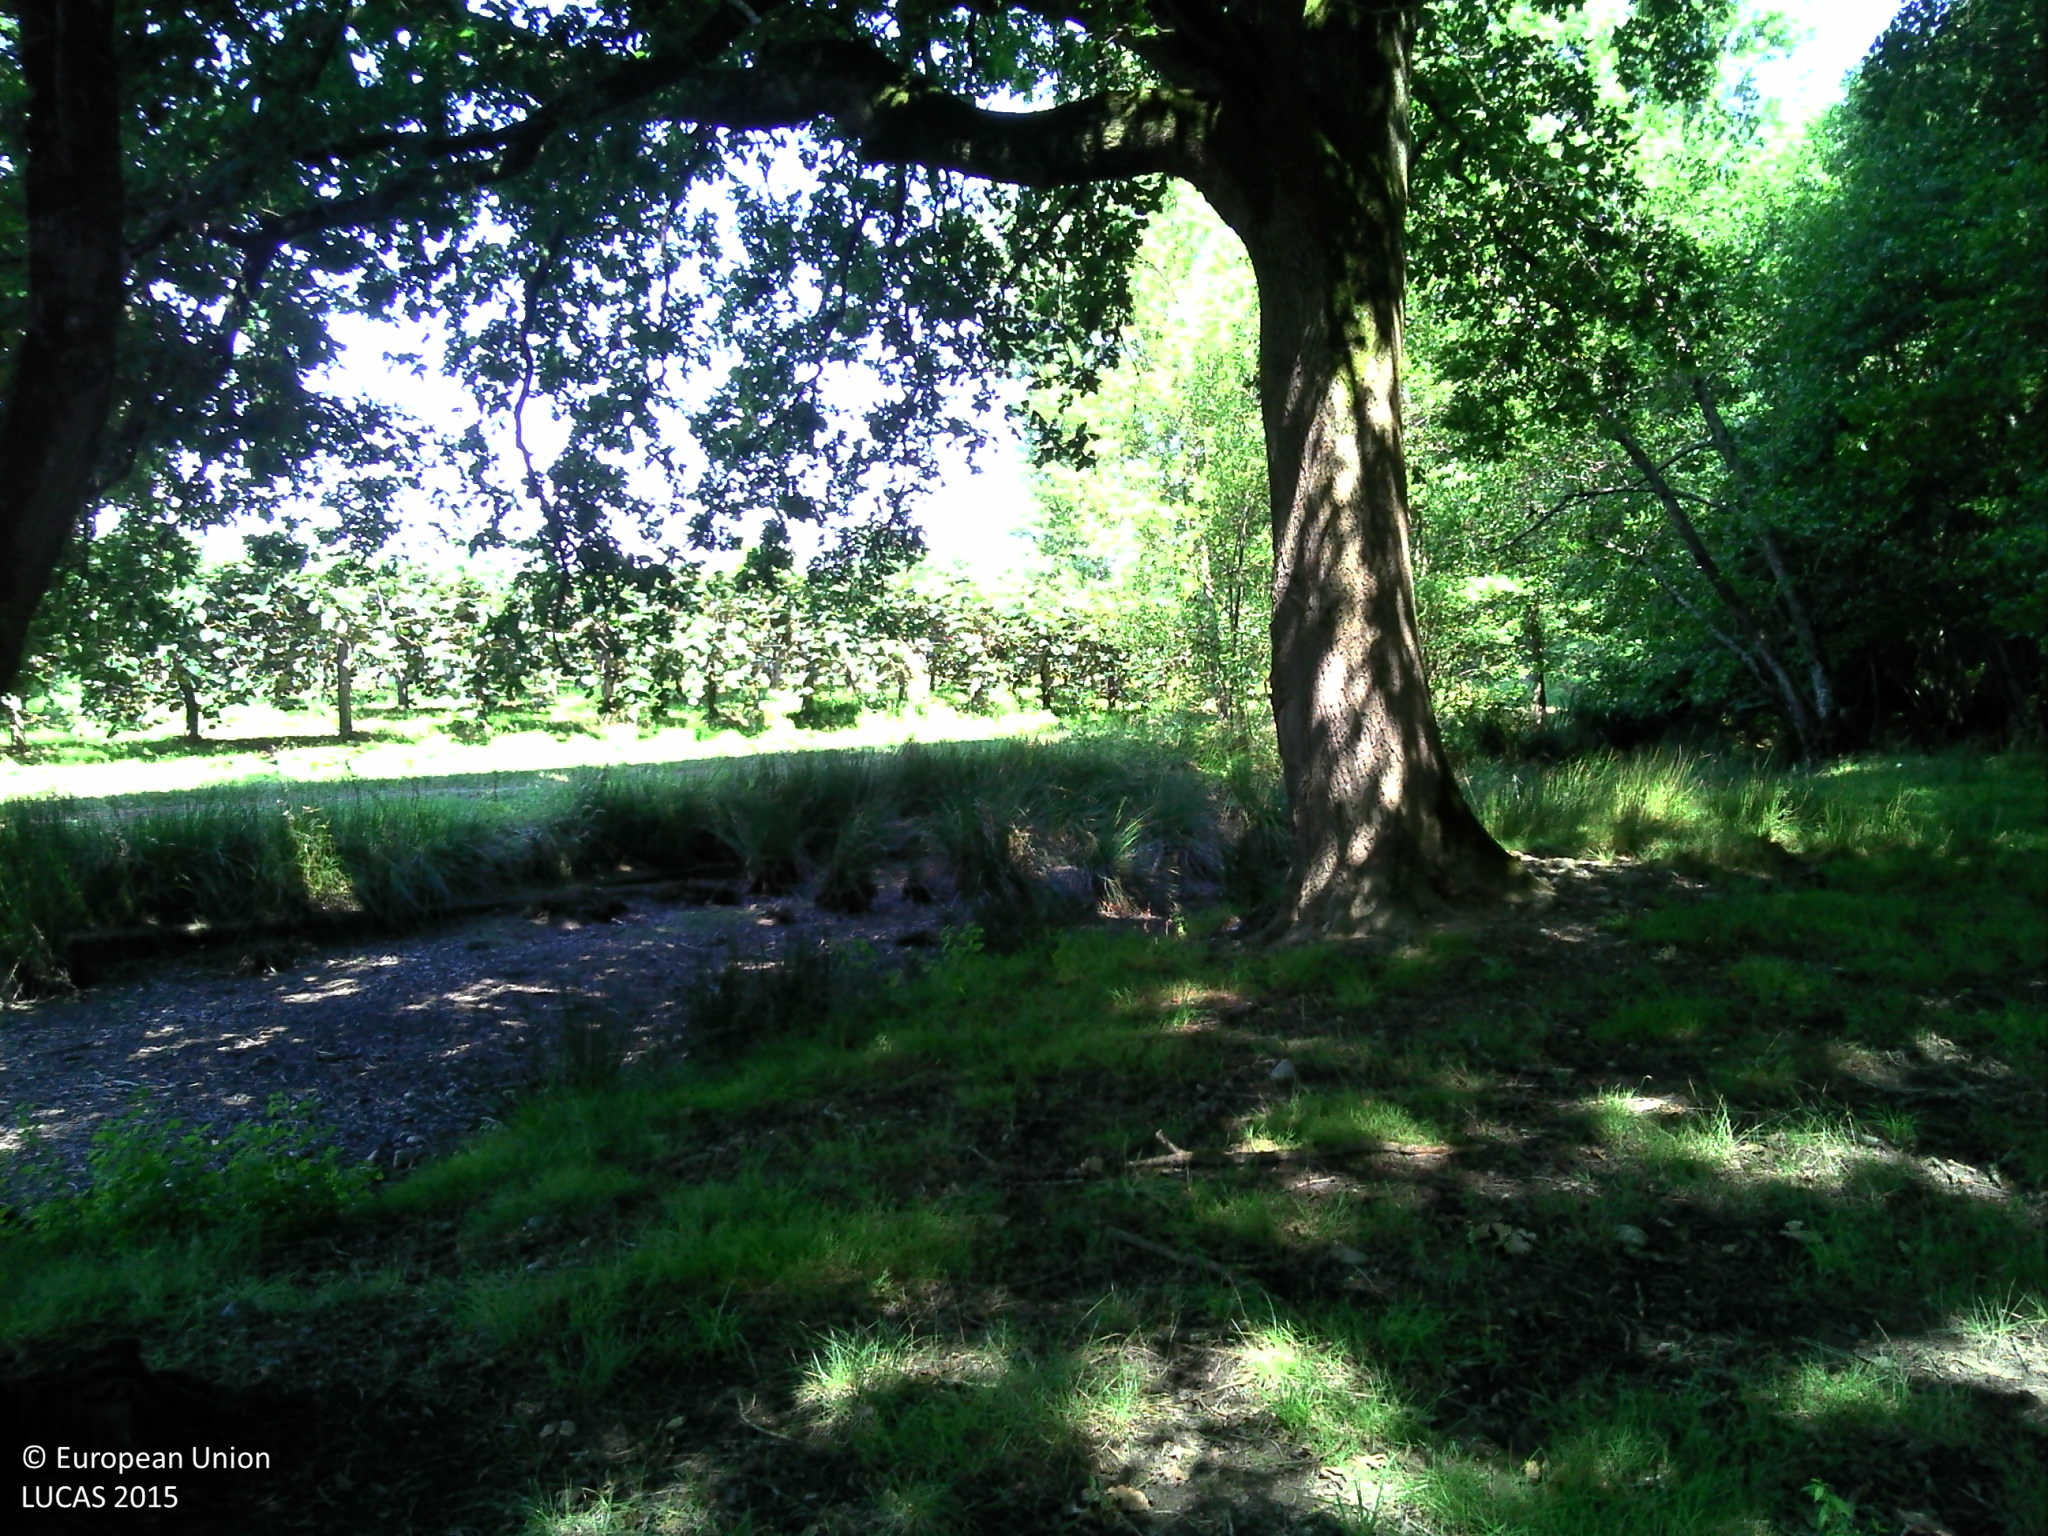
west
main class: Woodland
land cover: Broadleaved woodland
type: mesophytic deciduous forest
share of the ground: > 75 %
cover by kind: broadleaved forest trees 60 %, herbaceous plants 35 %, lichens and mosses 5 %
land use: Forestry
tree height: > 5 m
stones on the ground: < 10 %
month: August
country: FR
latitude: 43.7739
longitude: -0.7349
